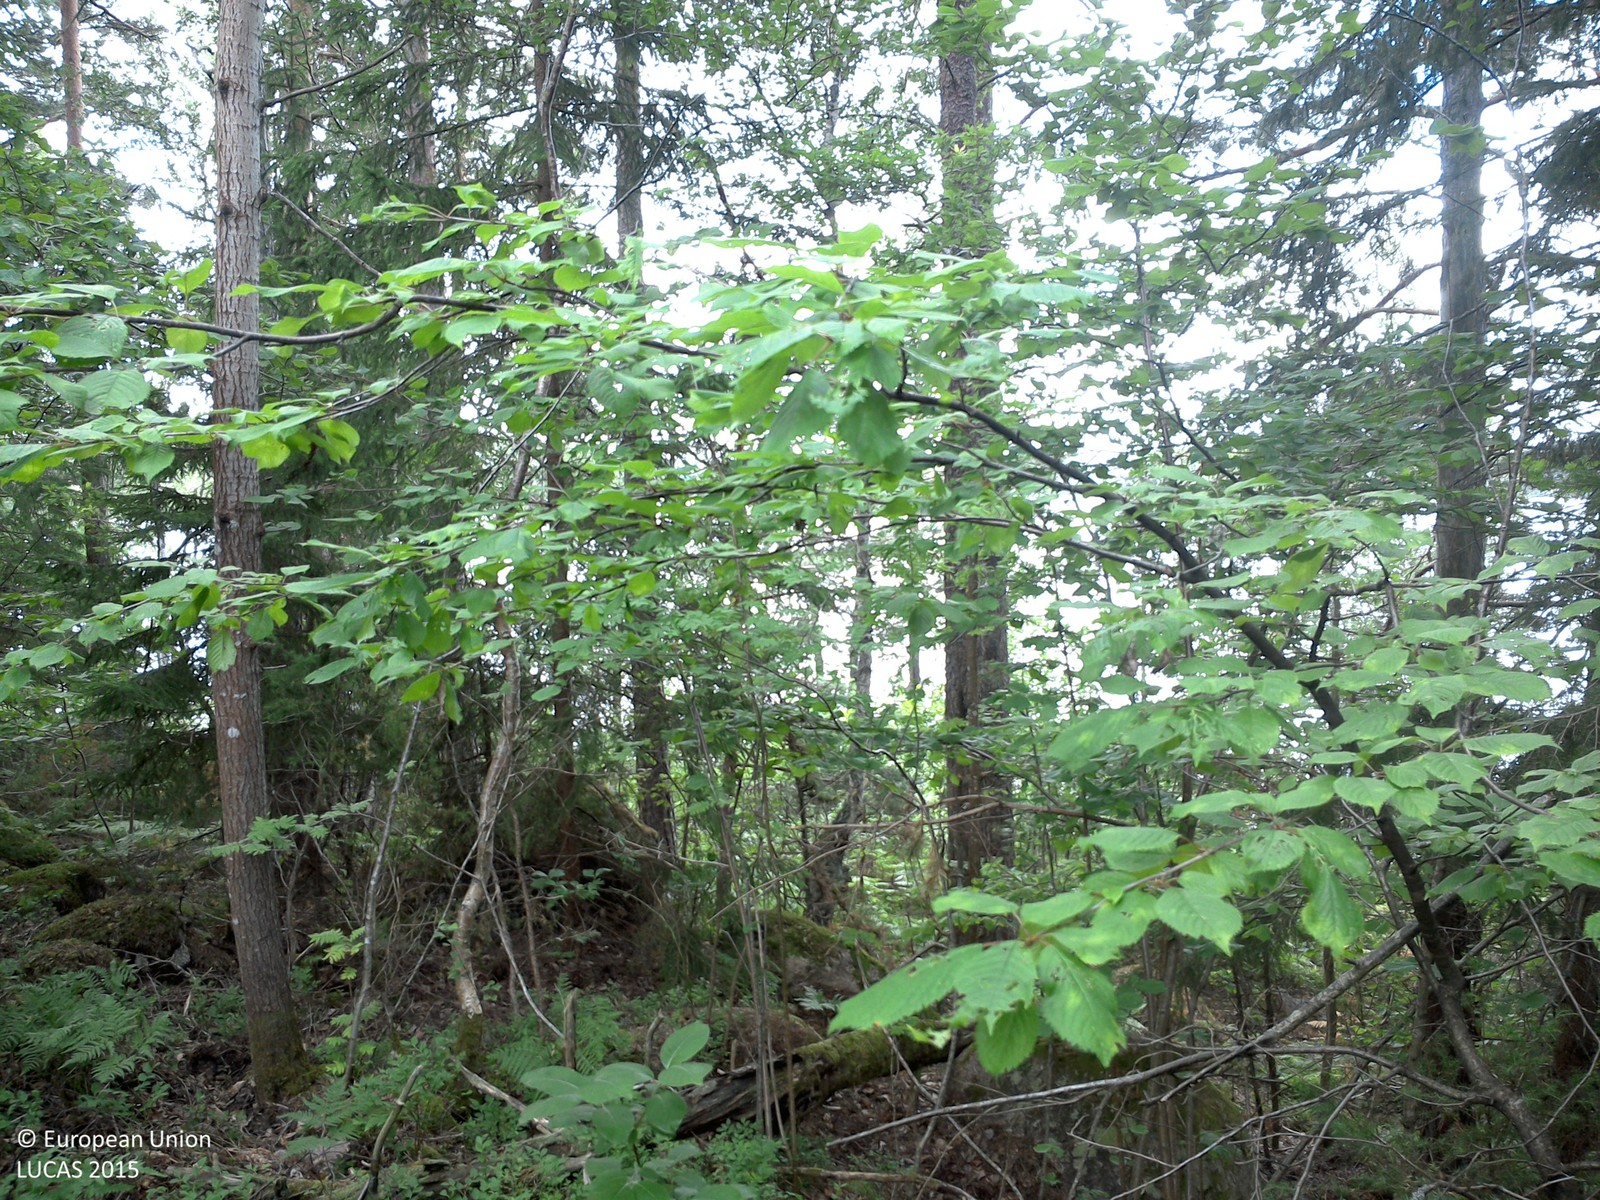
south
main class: Woodland
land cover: Spruce dominated mixed woodland
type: boreal forest
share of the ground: > 75 %
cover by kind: coniferous forest trees 50 %, broadleaved forest trees 25 %, herbaceous plants 15 %, lichens and mosses 10 %
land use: Forestry
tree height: > 5 m
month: July
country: SE
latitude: 57.9042
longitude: 16.0209
